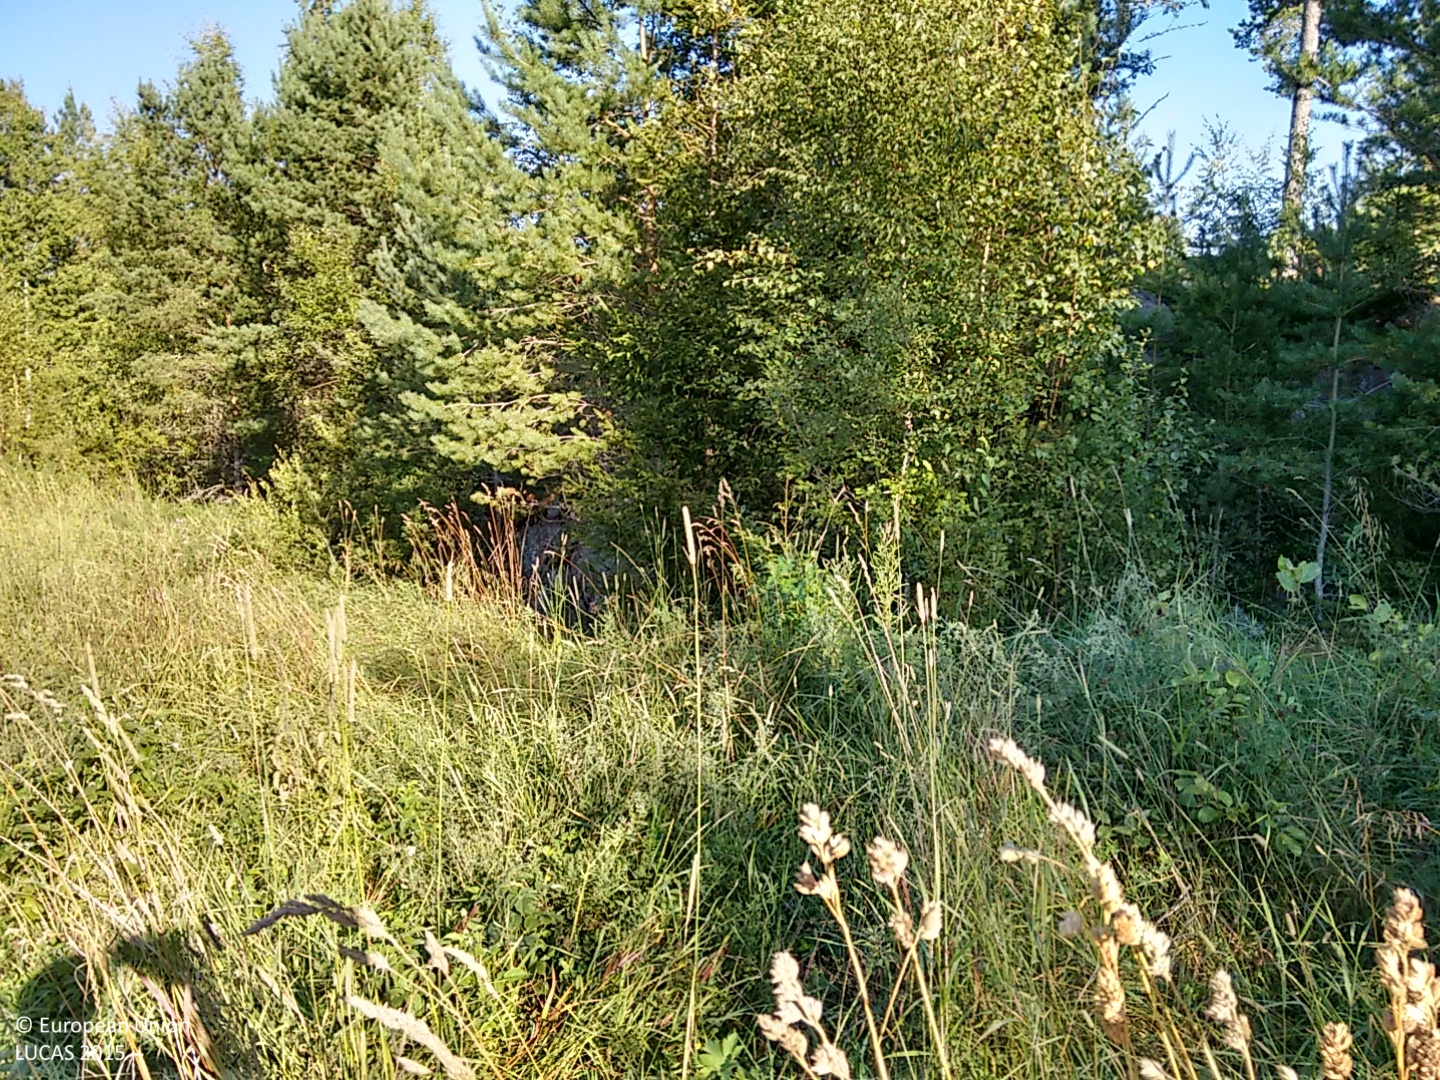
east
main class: Grassland
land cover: Spontaneously vegetated surfaces
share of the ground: > 75 %
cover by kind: herbaceous plants 100 %
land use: Semi-natural and natural areas not in use
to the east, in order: Spontaneously vegetated surfaces; Pine dominated mixed woodland; Ditches and canals; Pine dominated mixed woodland; Ditches and canals; Grass margins; Tracks; Grass margins; Spontaneously vegetated surfaces; Pine dominated mixed woodland; Spontaneously vegetated surfaces; Pine dominated mixed woodland; Broadleaved woodland; Inland fresh water bodies
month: August
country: FI
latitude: 60.3546
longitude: 19.9558
